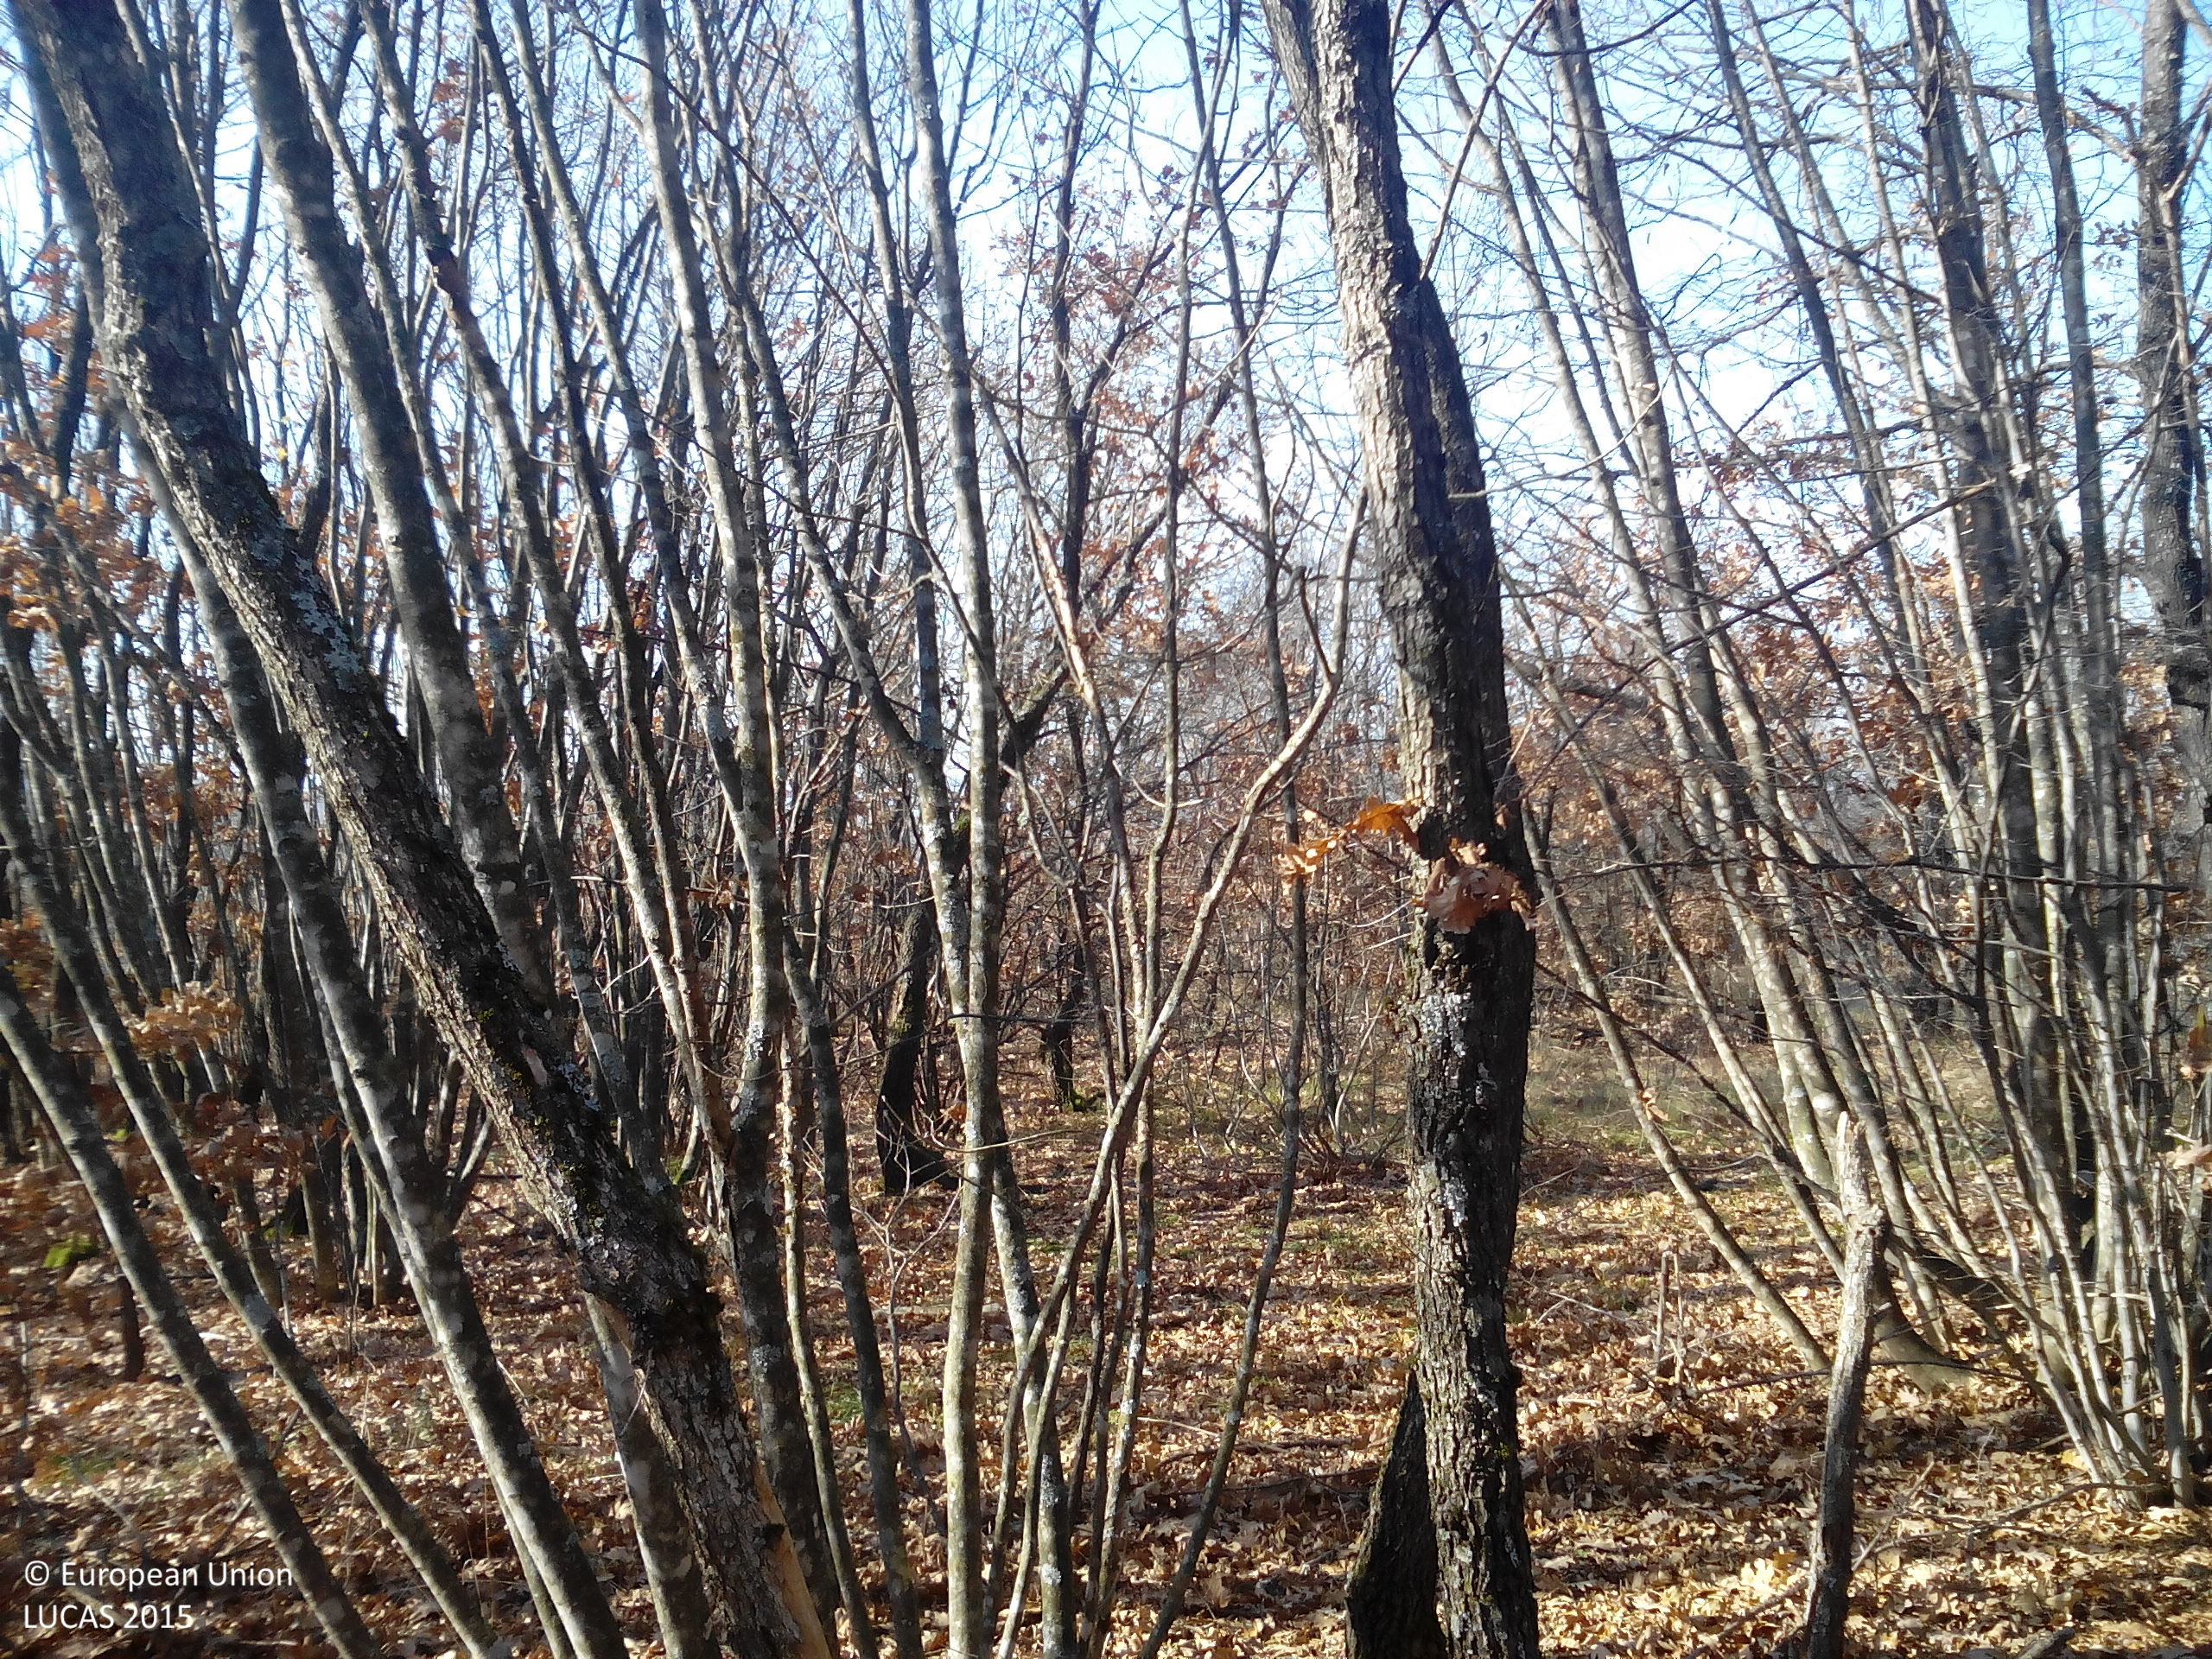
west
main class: Woodland
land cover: Broadleaved woodland
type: acidophilous oak and oak-birch forest
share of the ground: > 75 %
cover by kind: broadleaved forest trees 90 %, shrubs 5 %, herbaceous plants 5 %
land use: Forestry
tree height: > 5 m
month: November
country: BG
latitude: 43.1572
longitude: 24.0079
